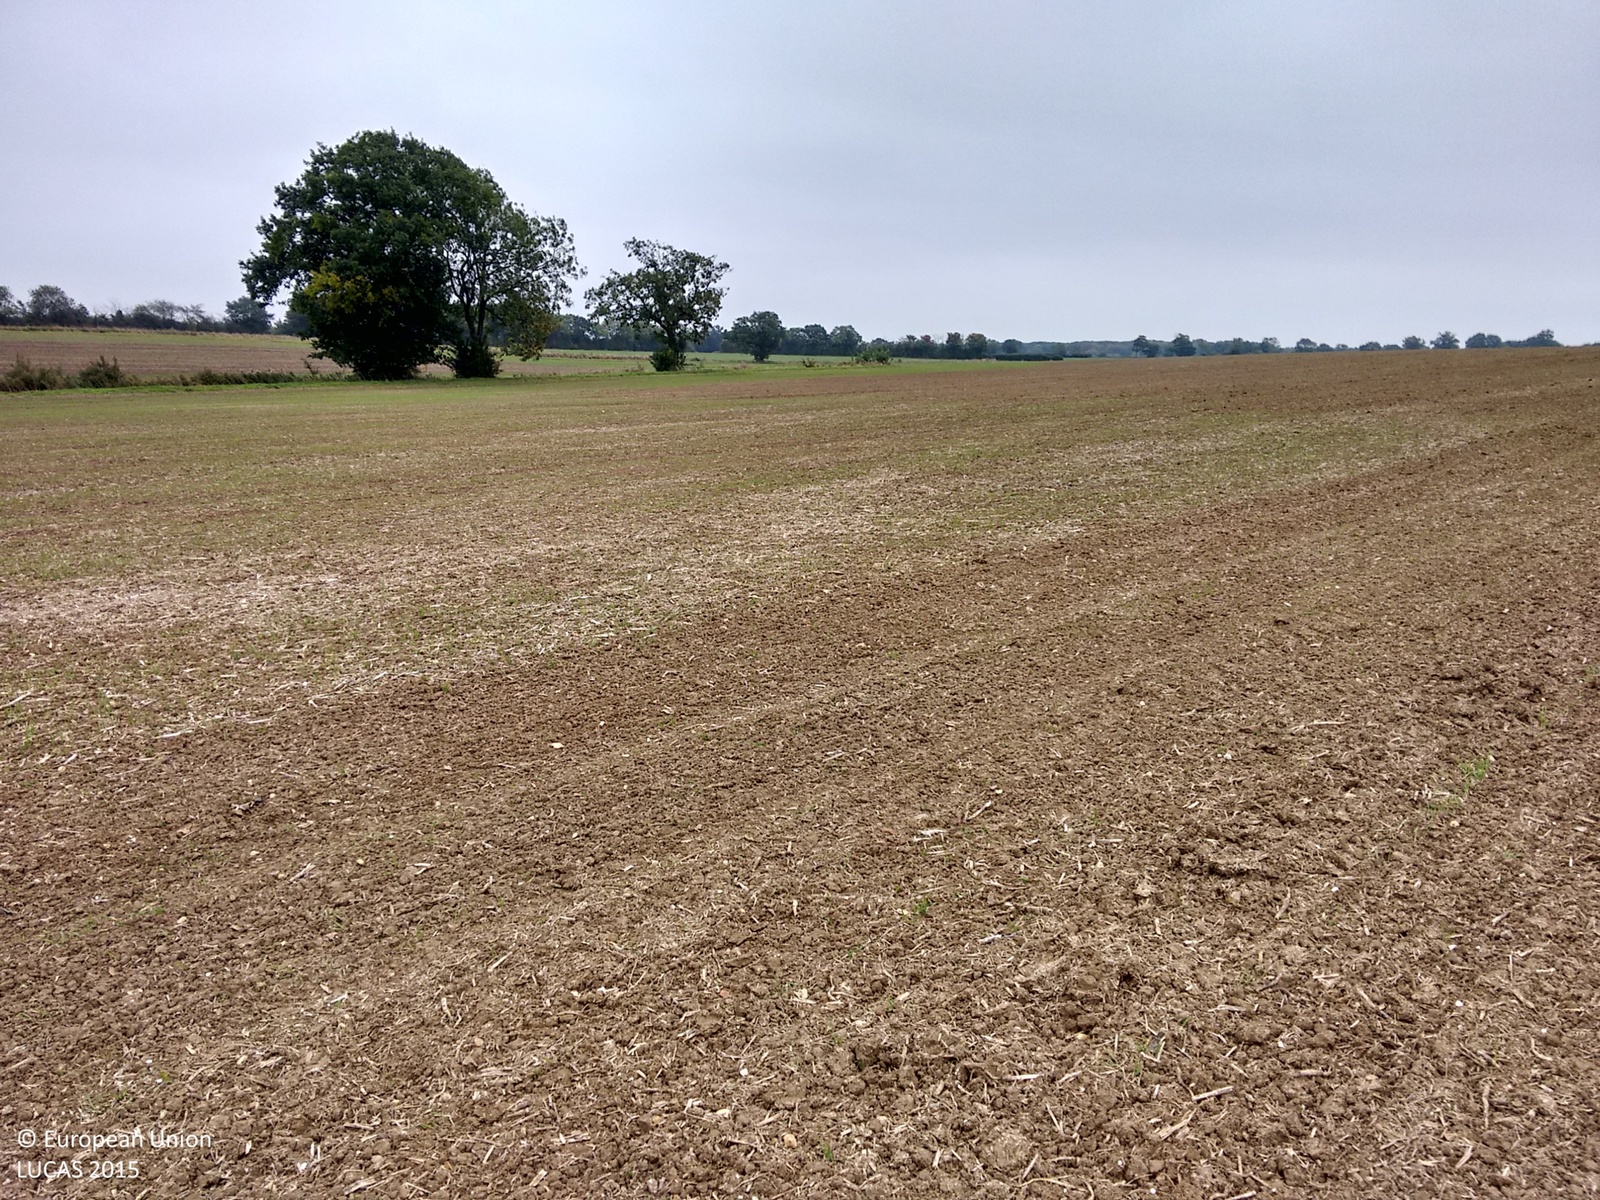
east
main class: Cropland
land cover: Common wheat
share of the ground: < 10 %
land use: Agriculture (excluding fallow land and kitchen gardens)
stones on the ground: 10 - 25 %
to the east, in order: Common wheat; Grass margins; Ditches and canals; Grass margins; Common wheat; Grass margins; Ditches and canals; Grass margins; Common wheat
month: October
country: GB
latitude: 52.3210
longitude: 0.9537
